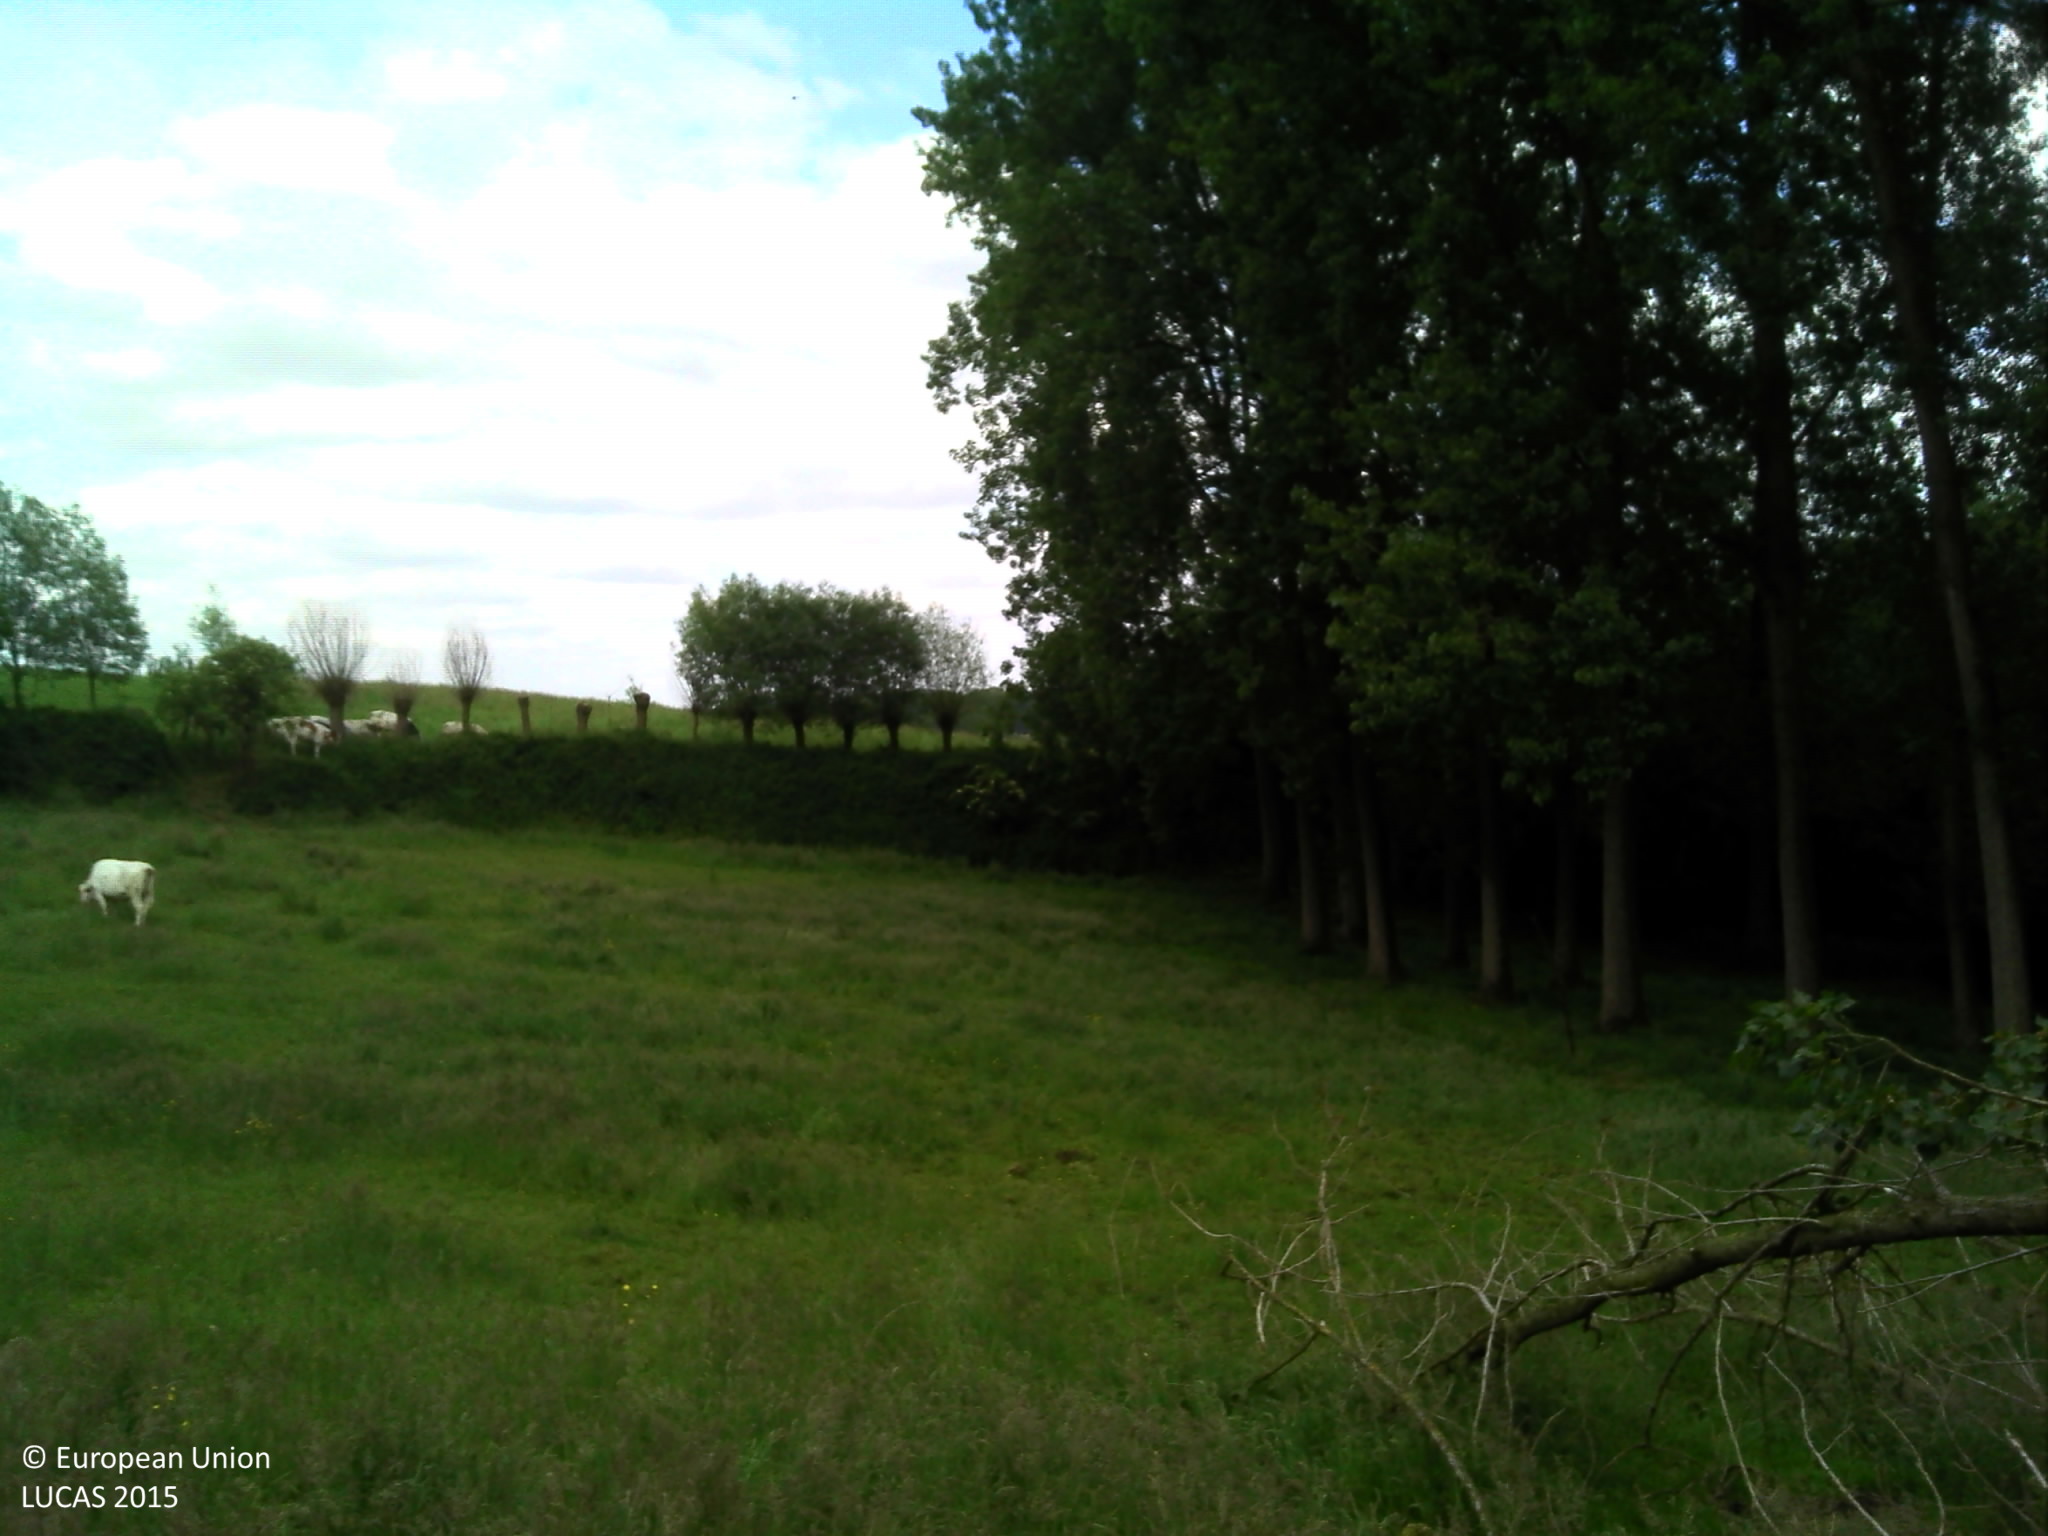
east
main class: Grassland
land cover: Grassland without tree/shrub cover
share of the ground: > 75 %
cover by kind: herbaceous plants 100 %
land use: Agriculture (excluding fallow land and kitchen gardens)
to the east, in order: Grassland without tree/shrub cover; Broadleaved woodland; Managed hedges; Lines of trees; Fences; Grassland without tree/shrub cover; Fences; Lines of trees; Maize
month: June
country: BE
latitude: 50.7788
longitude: 3.9097
